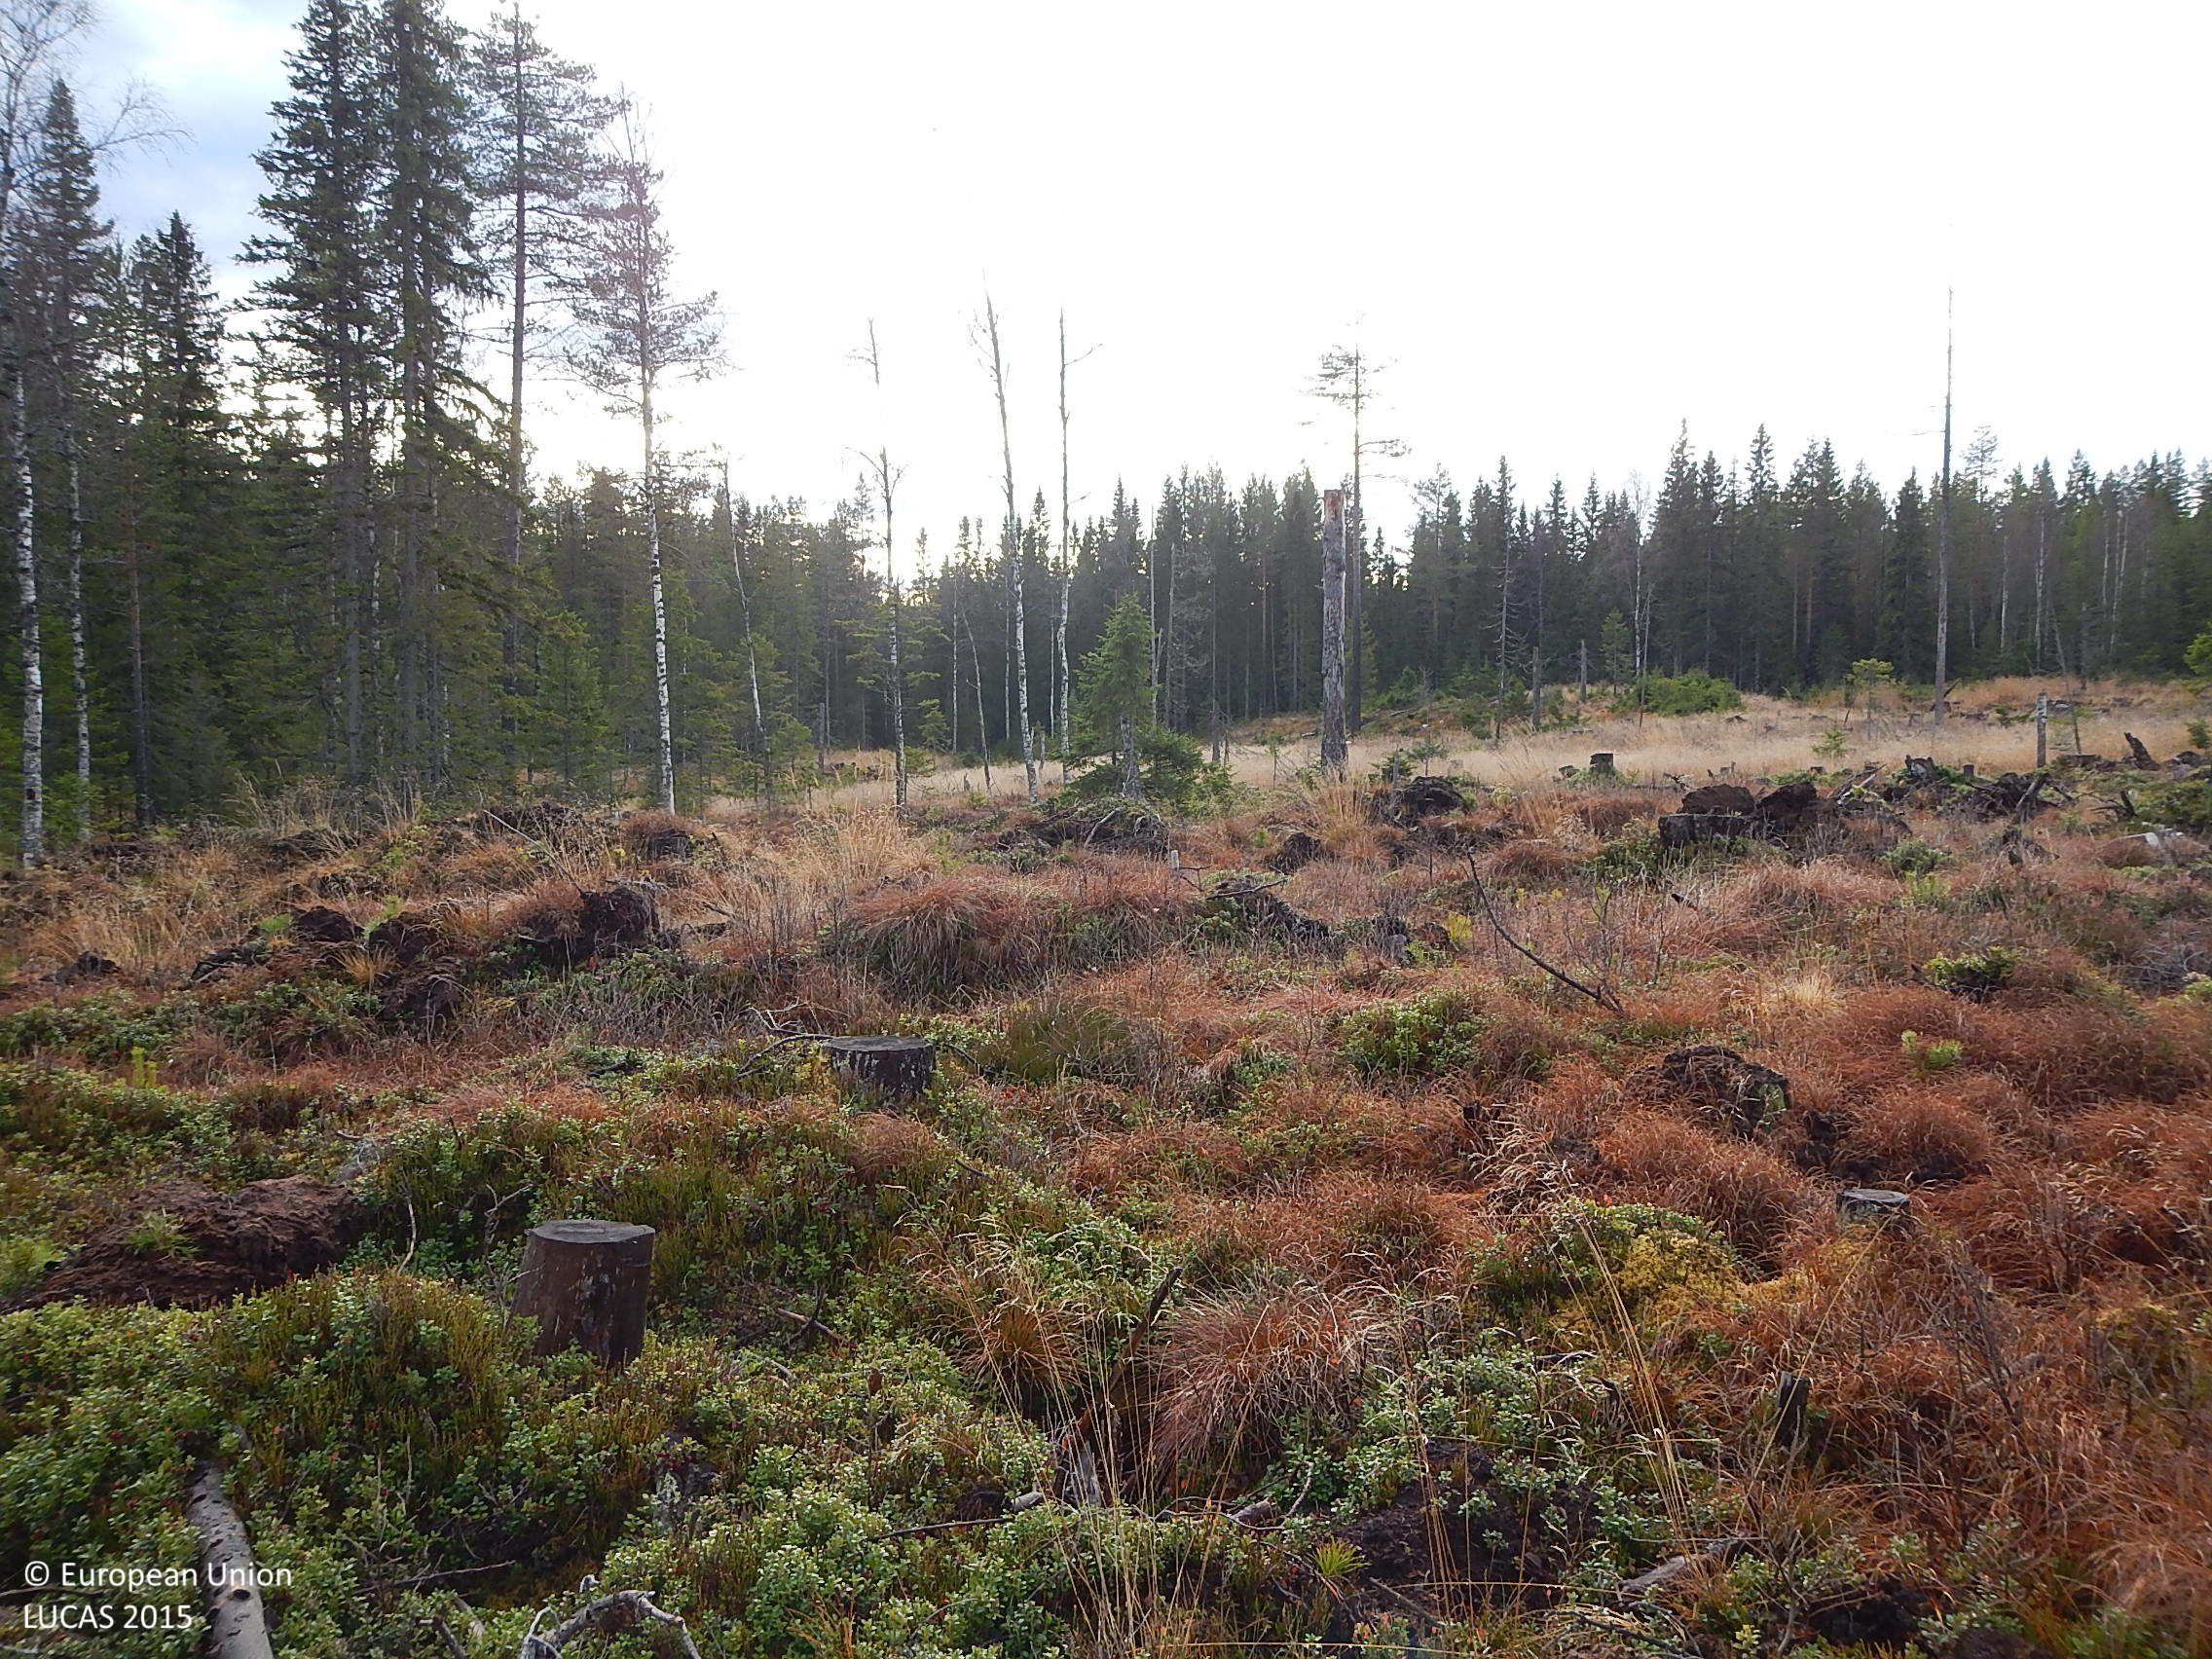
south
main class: Shrubland
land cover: Shrubland with sparse tree cover
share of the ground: > 75 %
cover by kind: shrubs 50 %, herbaceous plants 35 %, coniferous forest trees 5 %, lichens and mosses 5 %, unconsolidated bare surface 5 %
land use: Forestry
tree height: < 5 m
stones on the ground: < 10 %
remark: Clear cut
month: November
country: SE
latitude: 61.1150
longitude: 16.0911
